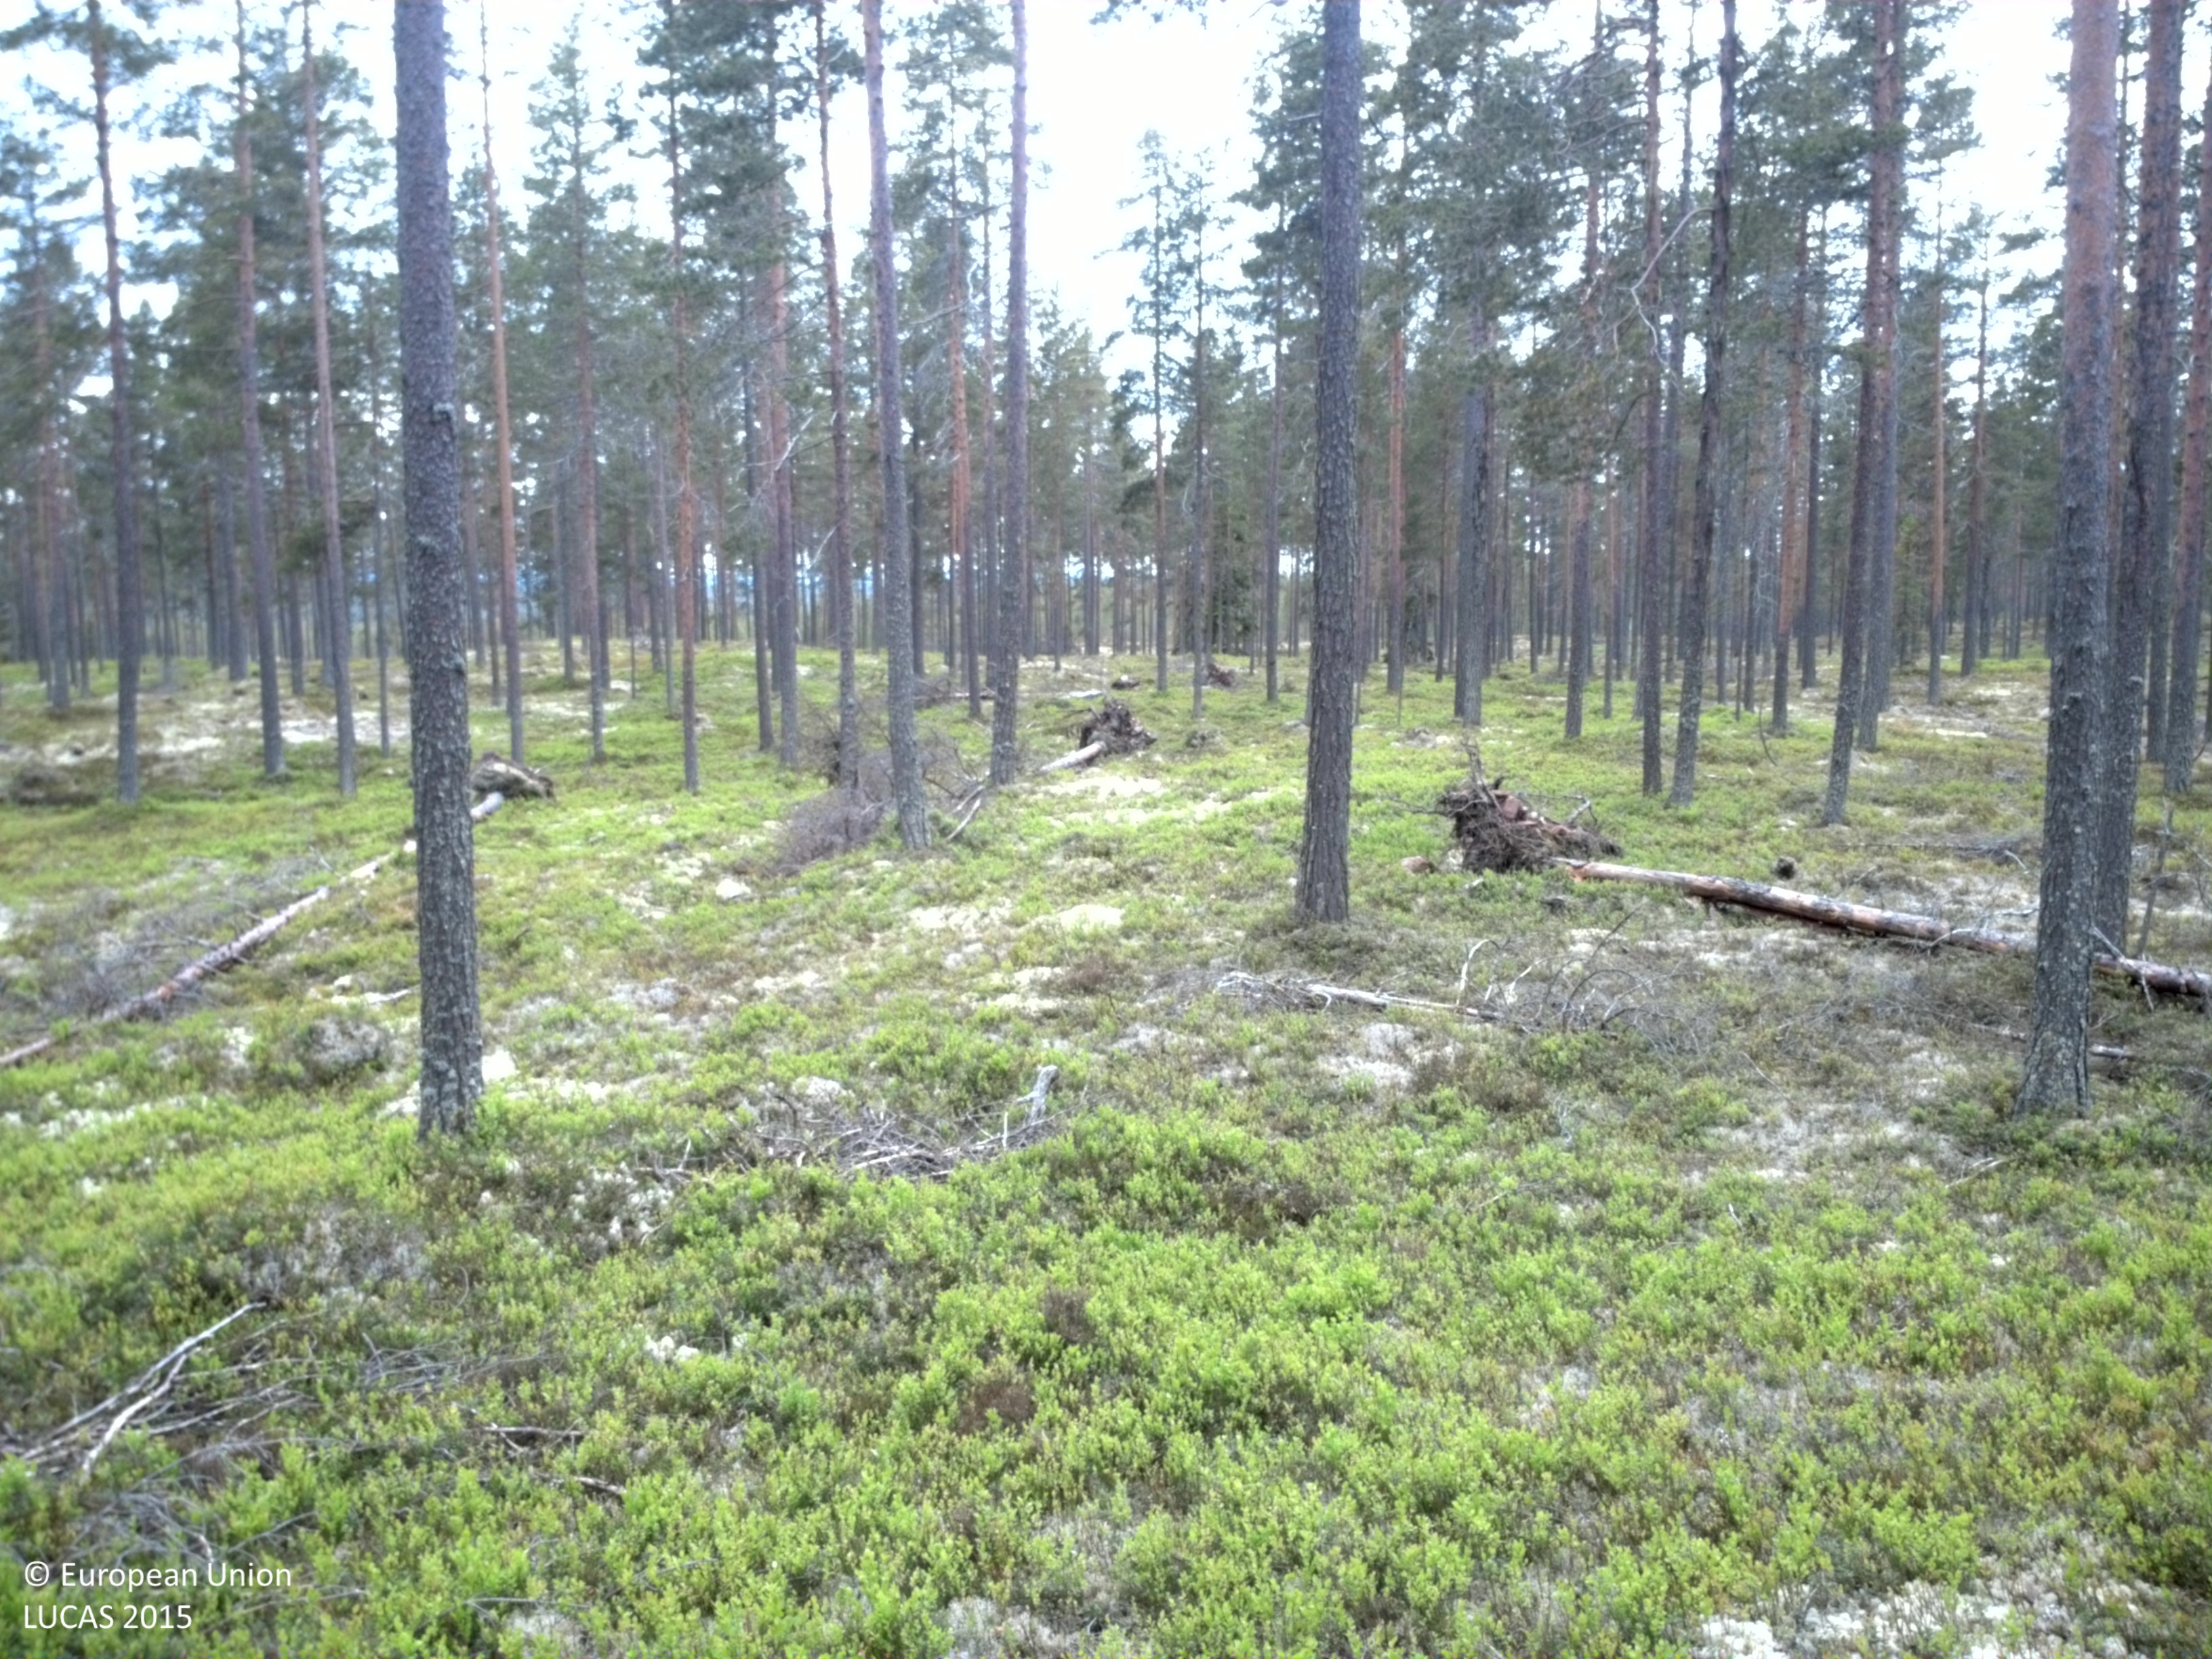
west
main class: Woodland
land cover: Pine dominated coniferous woodland
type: boreal forest
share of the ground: 50 - 75 %
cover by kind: coniferous forest trees 65 %, herbaceous plants 20 %, lichens and mosses 15 %
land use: Forestry
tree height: > 5 m
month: June
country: SE
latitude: 61.2878
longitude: 13.6262
